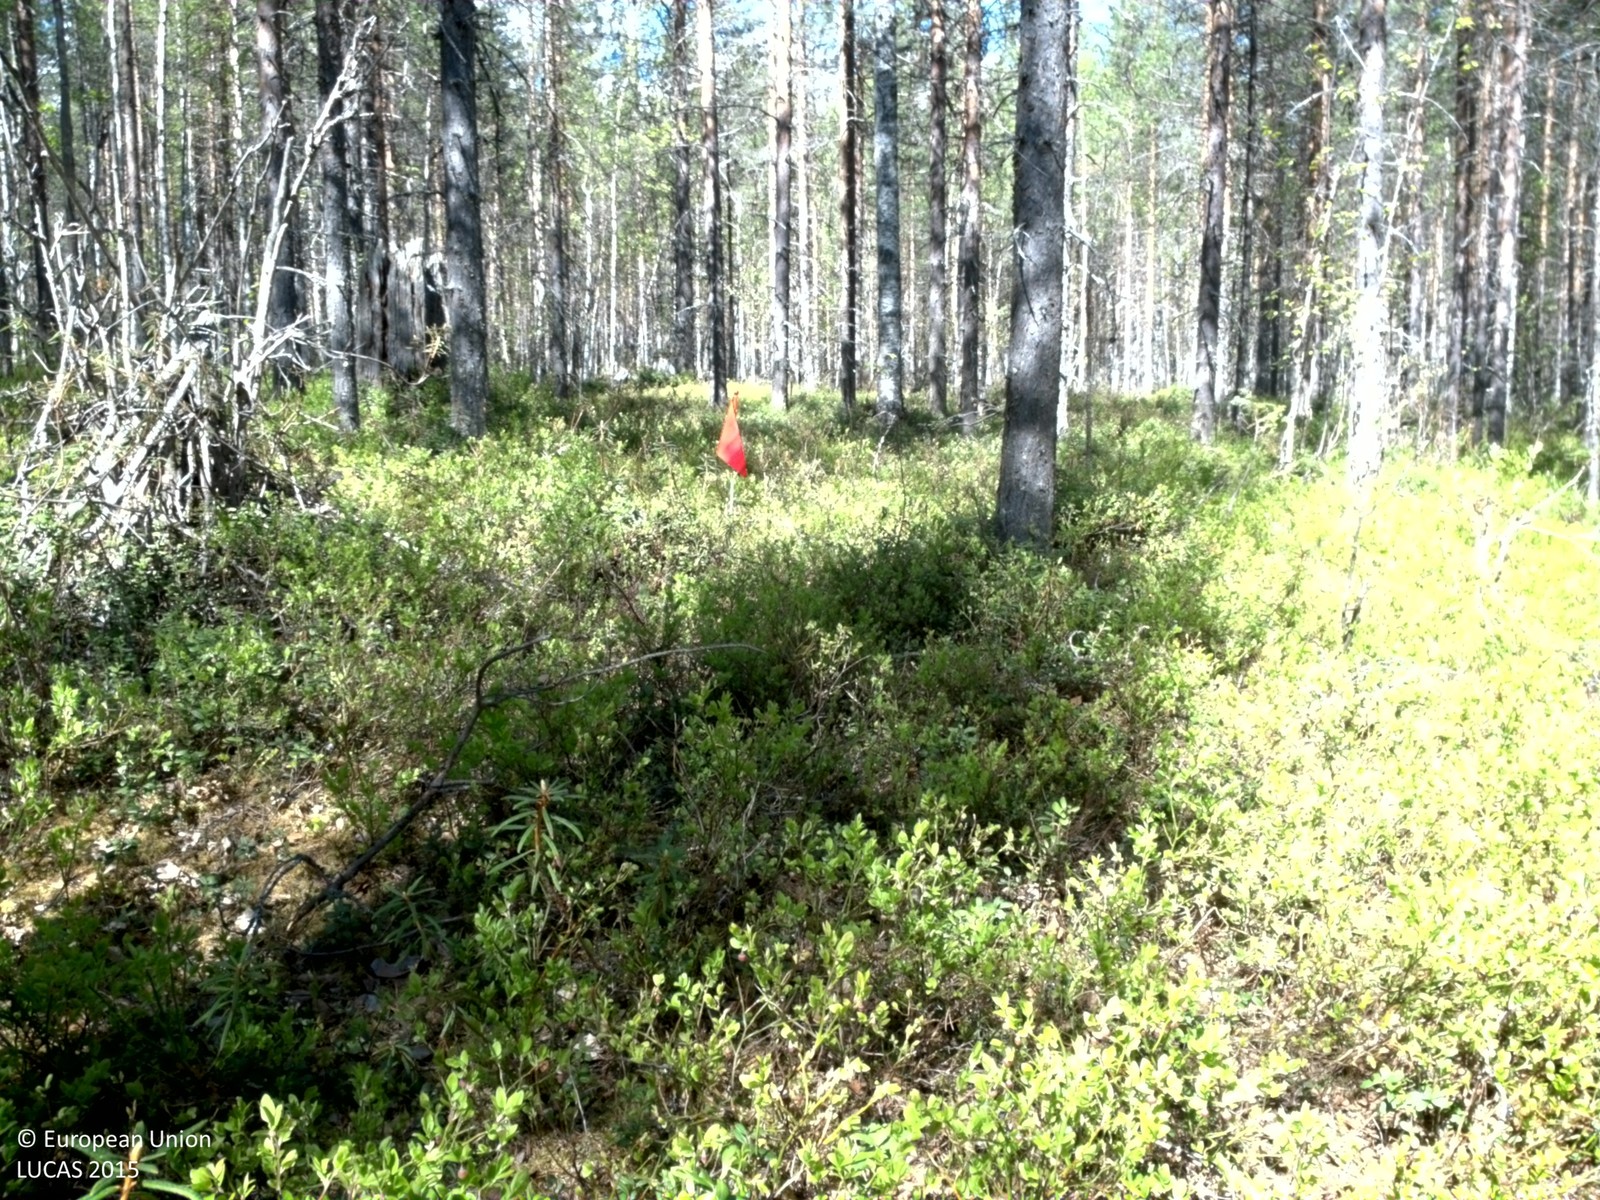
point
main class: Woodland
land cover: Pine dominated coniferous woodland
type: boreal forest
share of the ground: 50 - 75 %
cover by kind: coniferous forest trees 60 %, shrubs 30 %, broadleaved forest trees 10 %
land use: Forestry
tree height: > 5 m
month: June
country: SE
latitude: 66.5925
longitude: 22.3531
